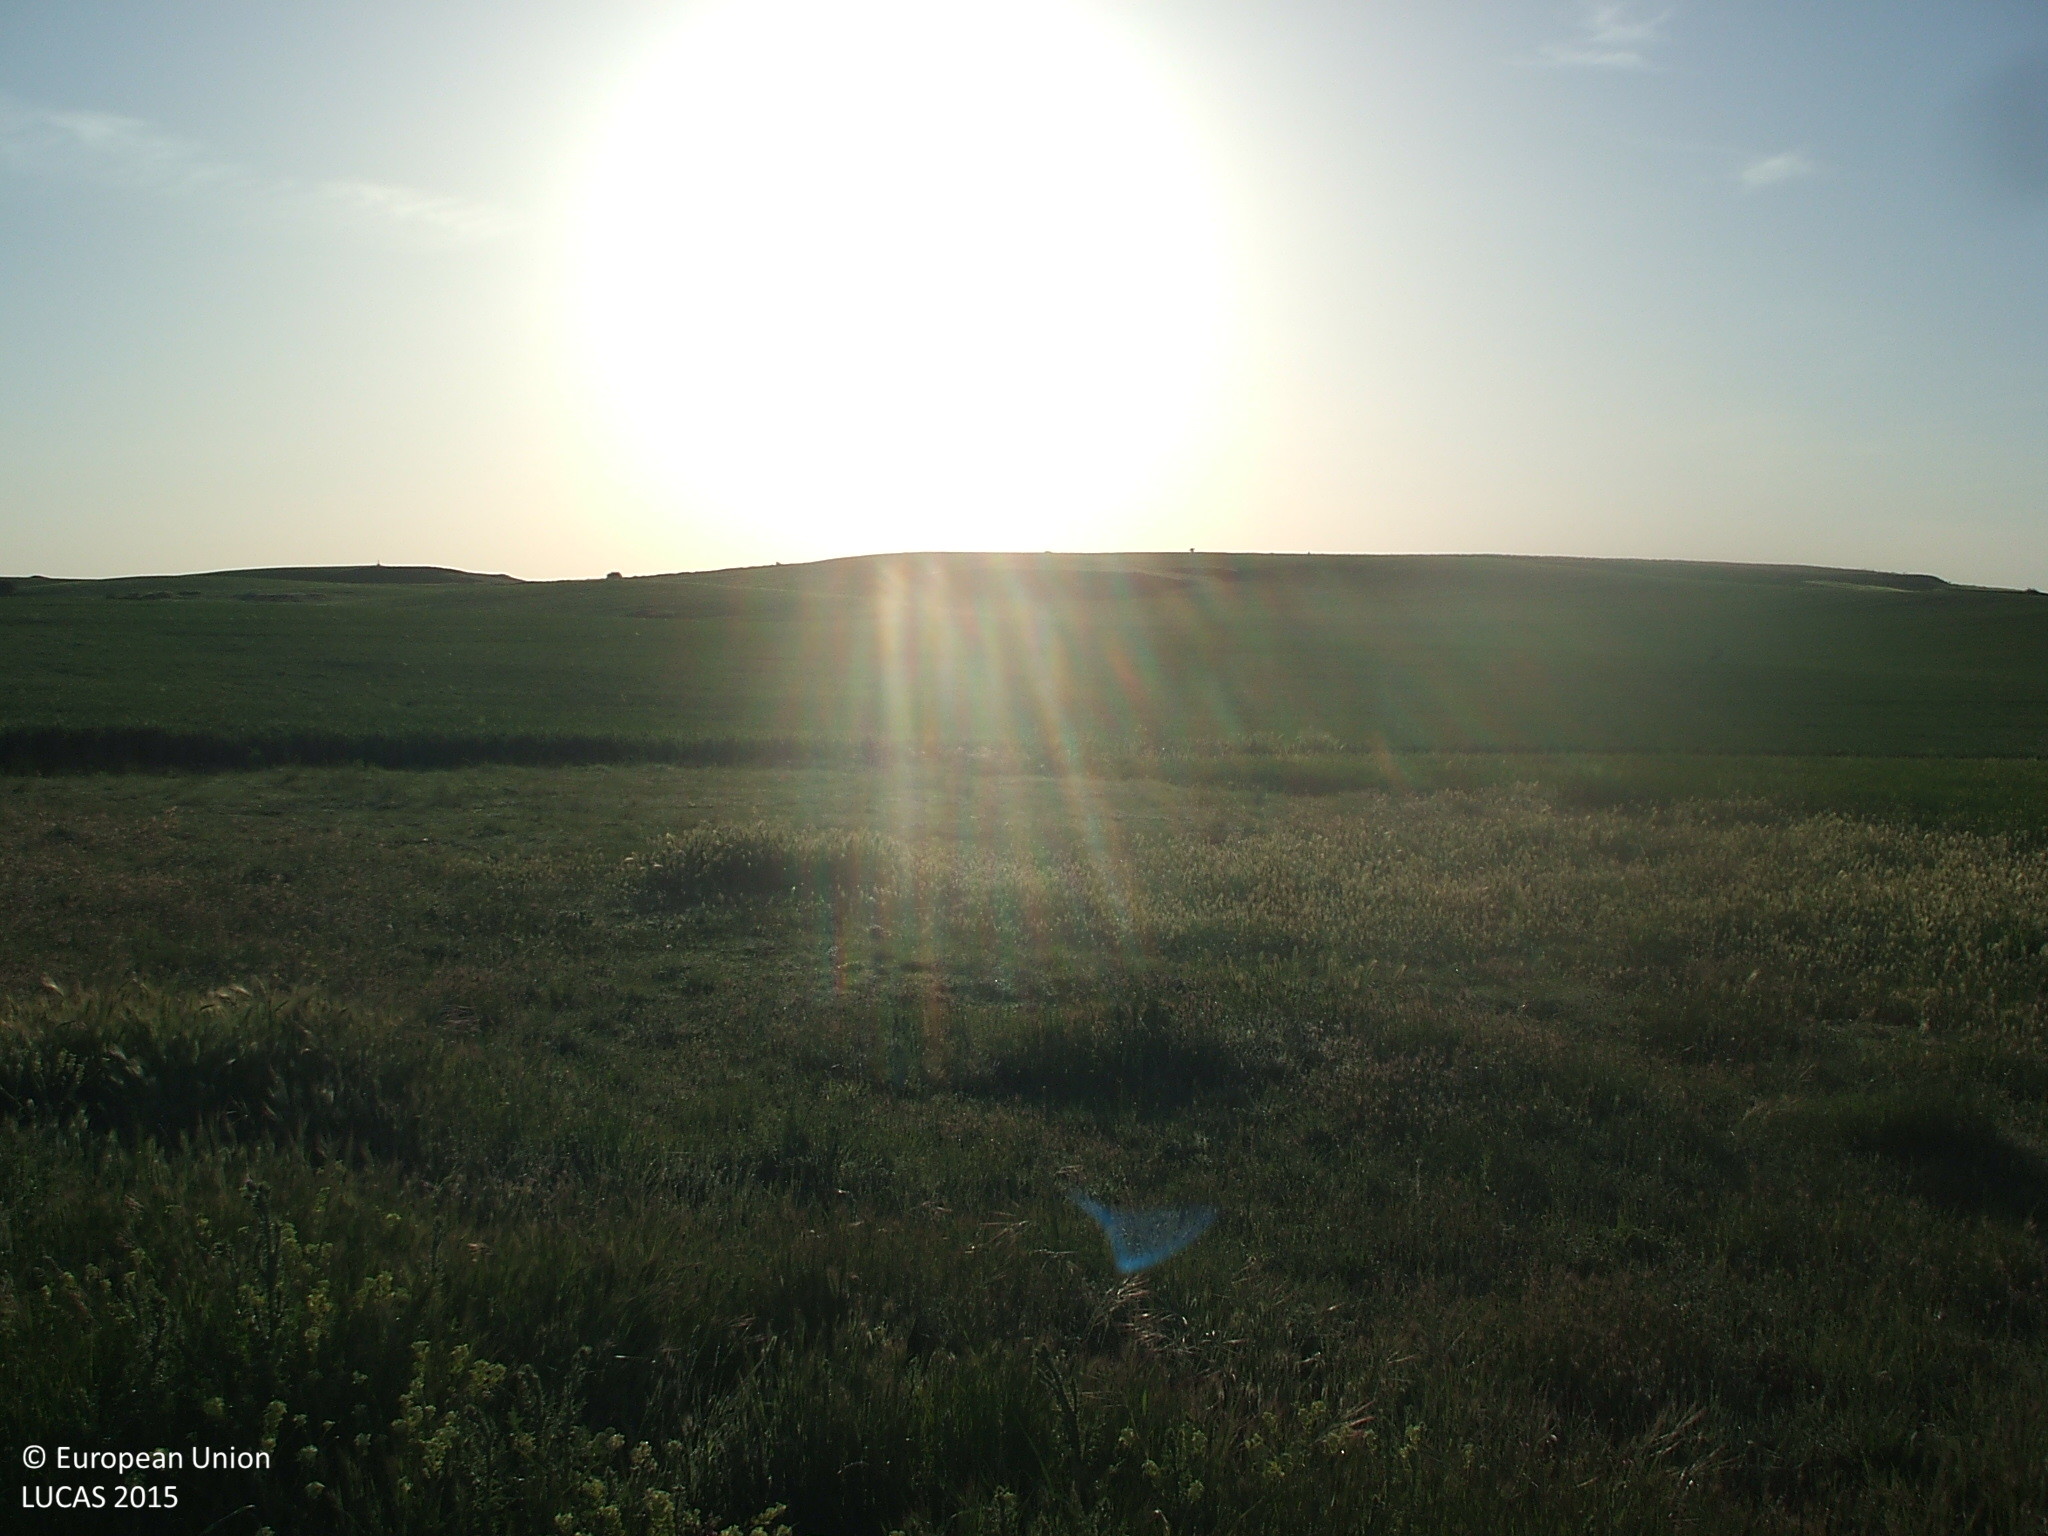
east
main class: Grassland
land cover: Spontaneously vegetated surfaces
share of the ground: > 75 %
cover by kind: herbaceous plants 100 %
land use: Semi-natural and natural areas not in use
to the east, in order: Spontaneously vegetated surfaces; Barley; Common wheat
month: May
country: ES
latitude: 40.7101
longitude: -3.0415
